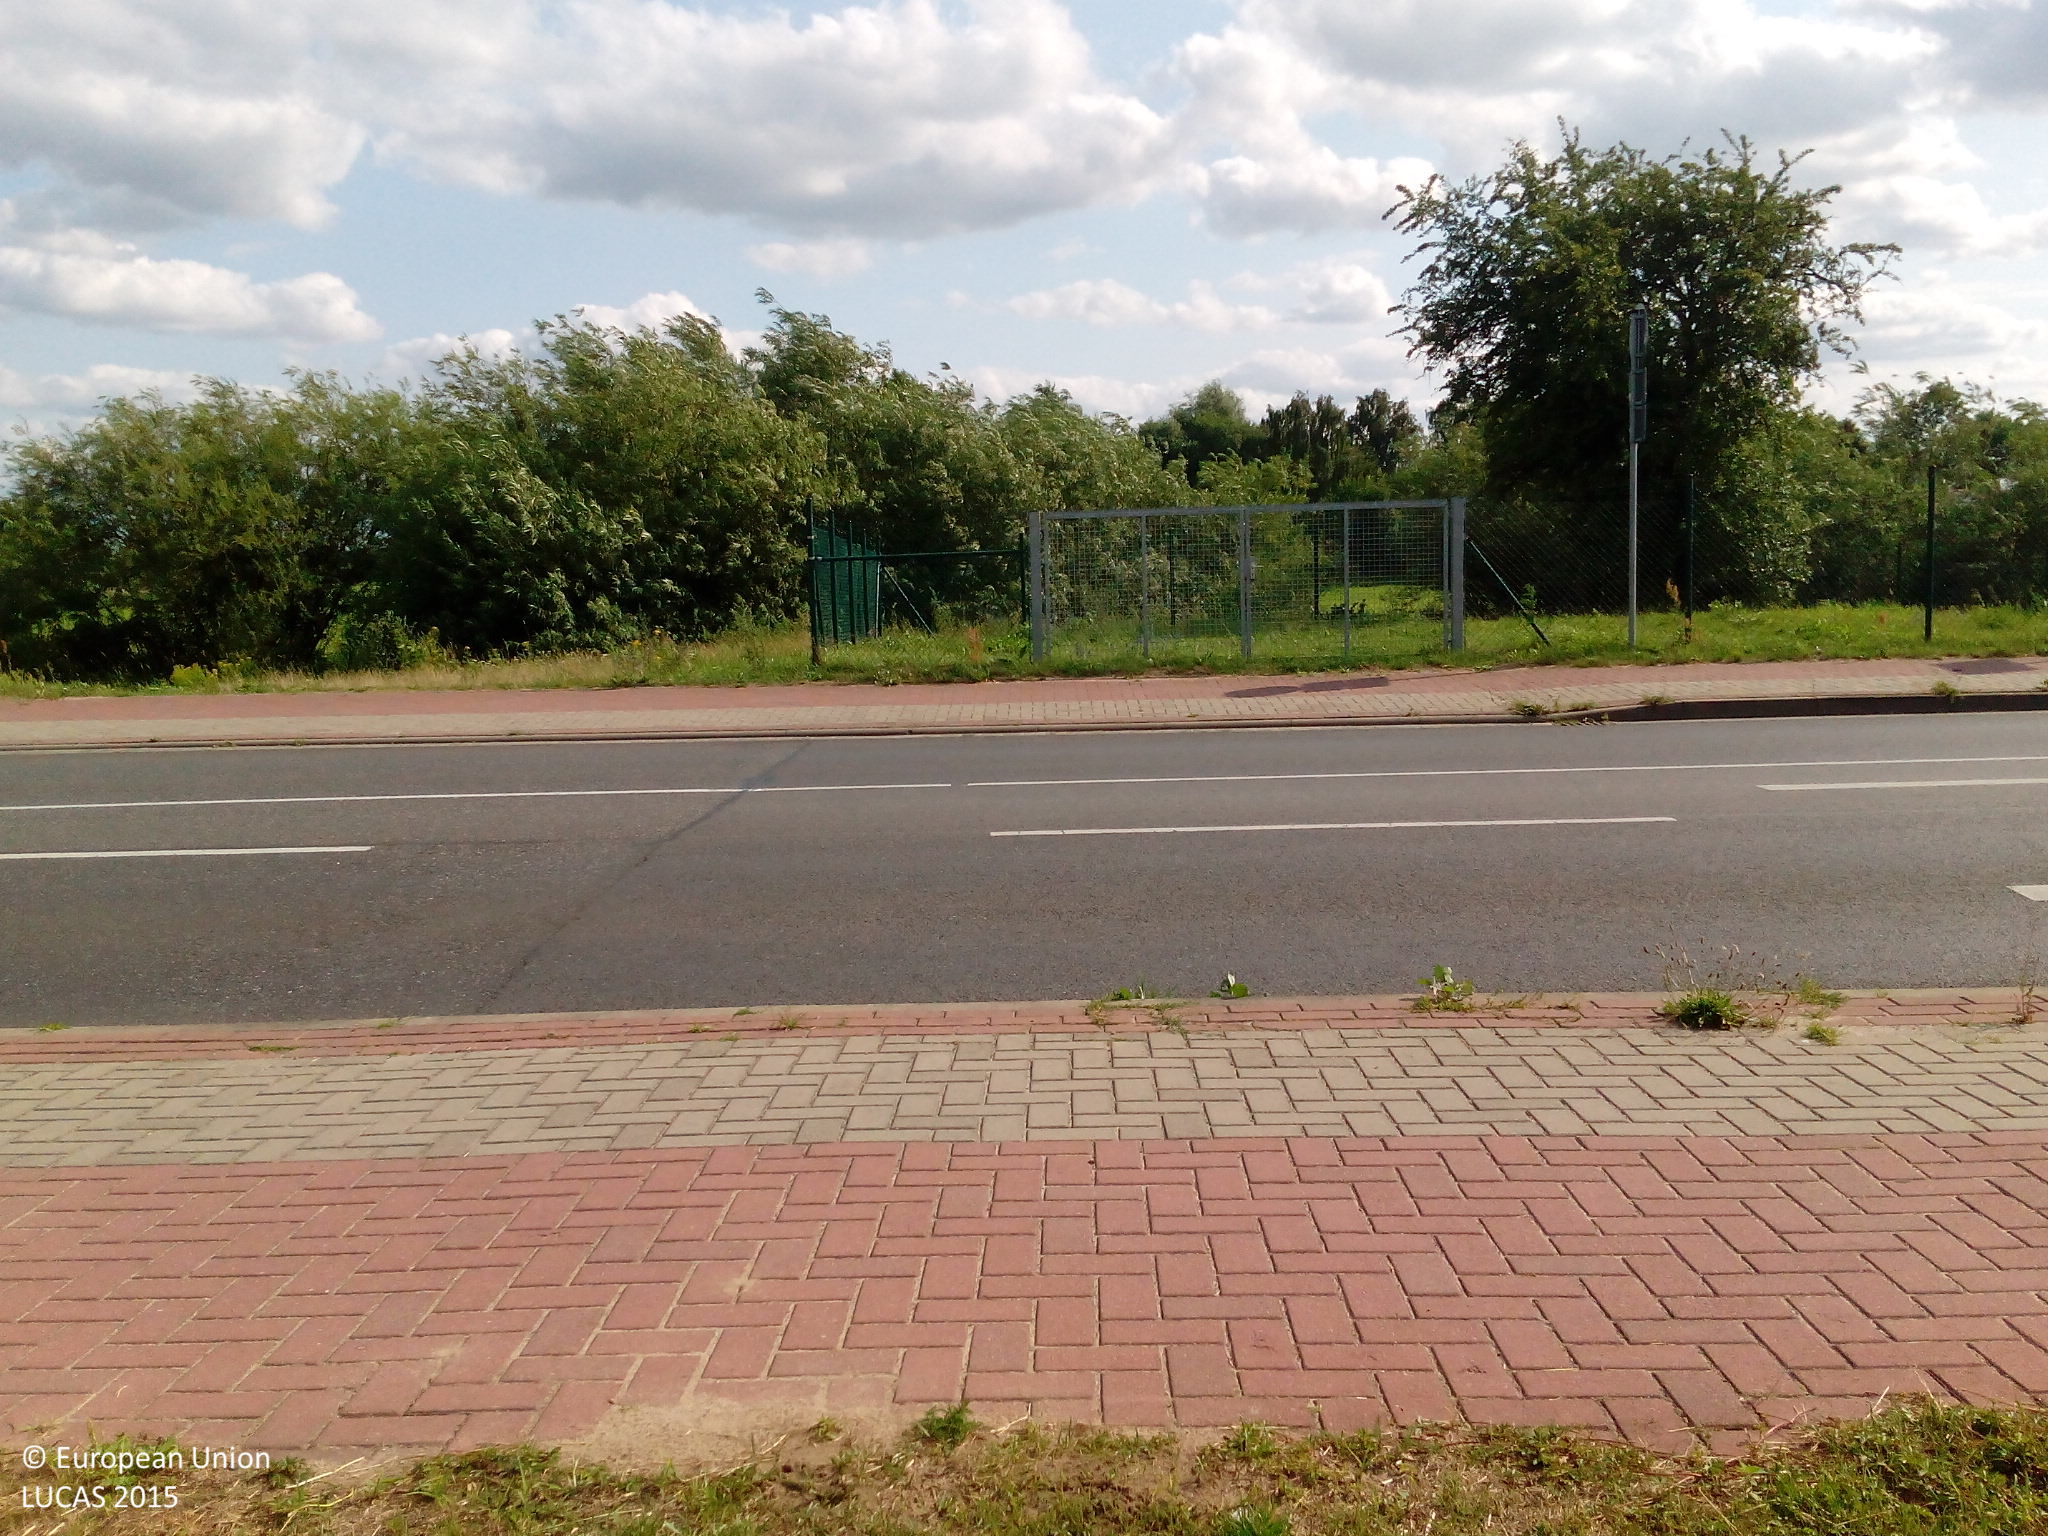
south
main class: Grassland
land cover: Grassland without tree/shrub cover
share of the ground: > 75 %
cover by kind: herbaceous plants 75 %, consolidated bare surface 25 %
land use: Road transport
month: July
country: DE
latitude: 53.4551
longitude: 14.2022
